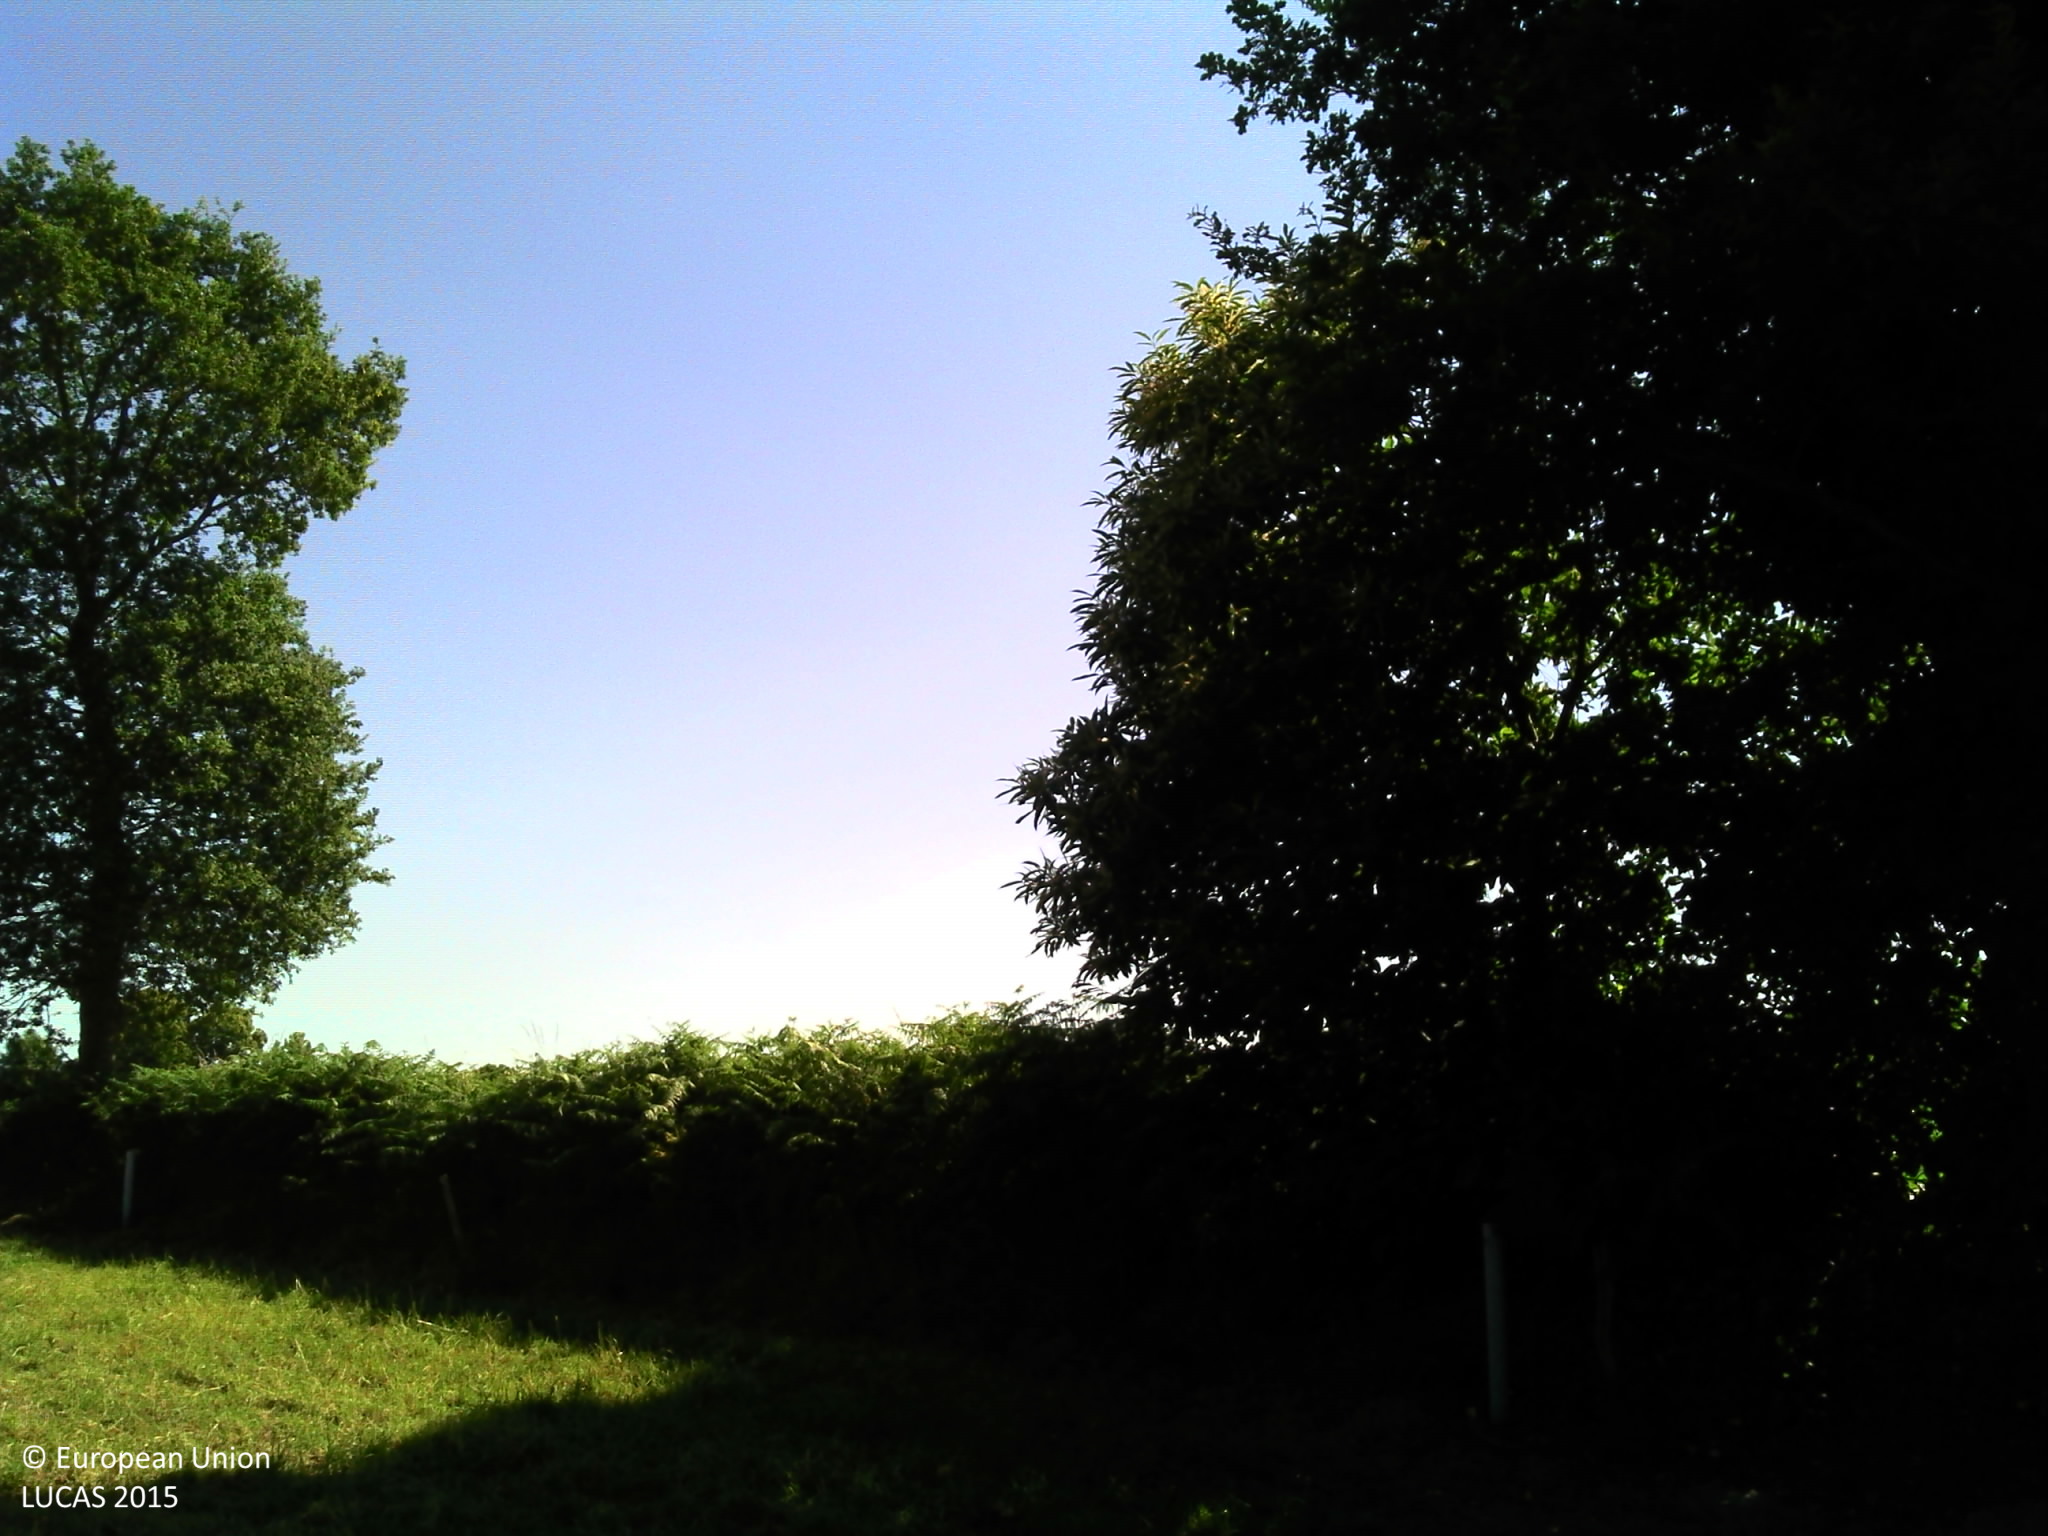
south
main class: Grassland
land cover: Grassland without tree/shrub cover
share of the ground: > 75 %
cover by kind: herbaceous plants 100 %
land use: Agriculture (excluding fallow land and kitchen gardens)
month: July
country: FR
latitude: 48.3865
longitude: -2.1414
